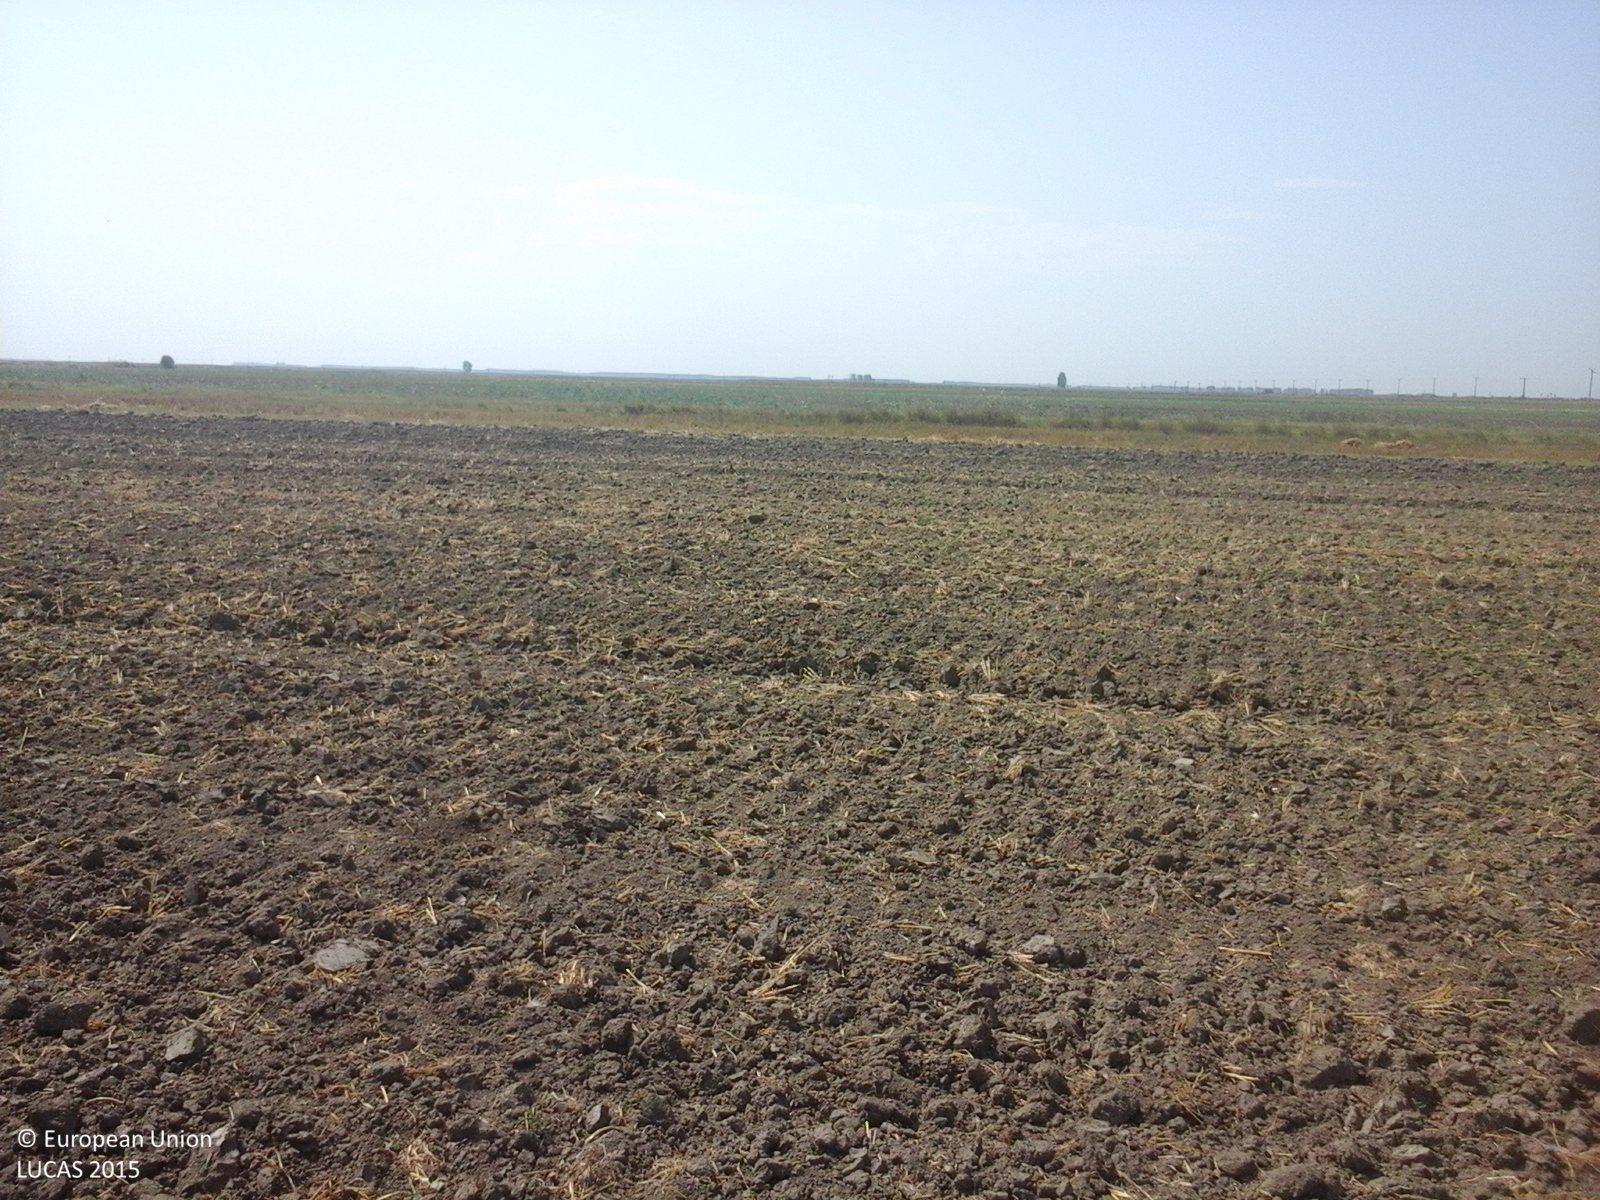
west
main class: Cropland
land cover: Durum wheat
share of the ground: < 10 %
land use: Agriculture (excluding fallow land and kitchen gardens)
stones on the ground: < 10 %
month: August
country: RO
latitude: 44.8162
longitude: 28.0567
